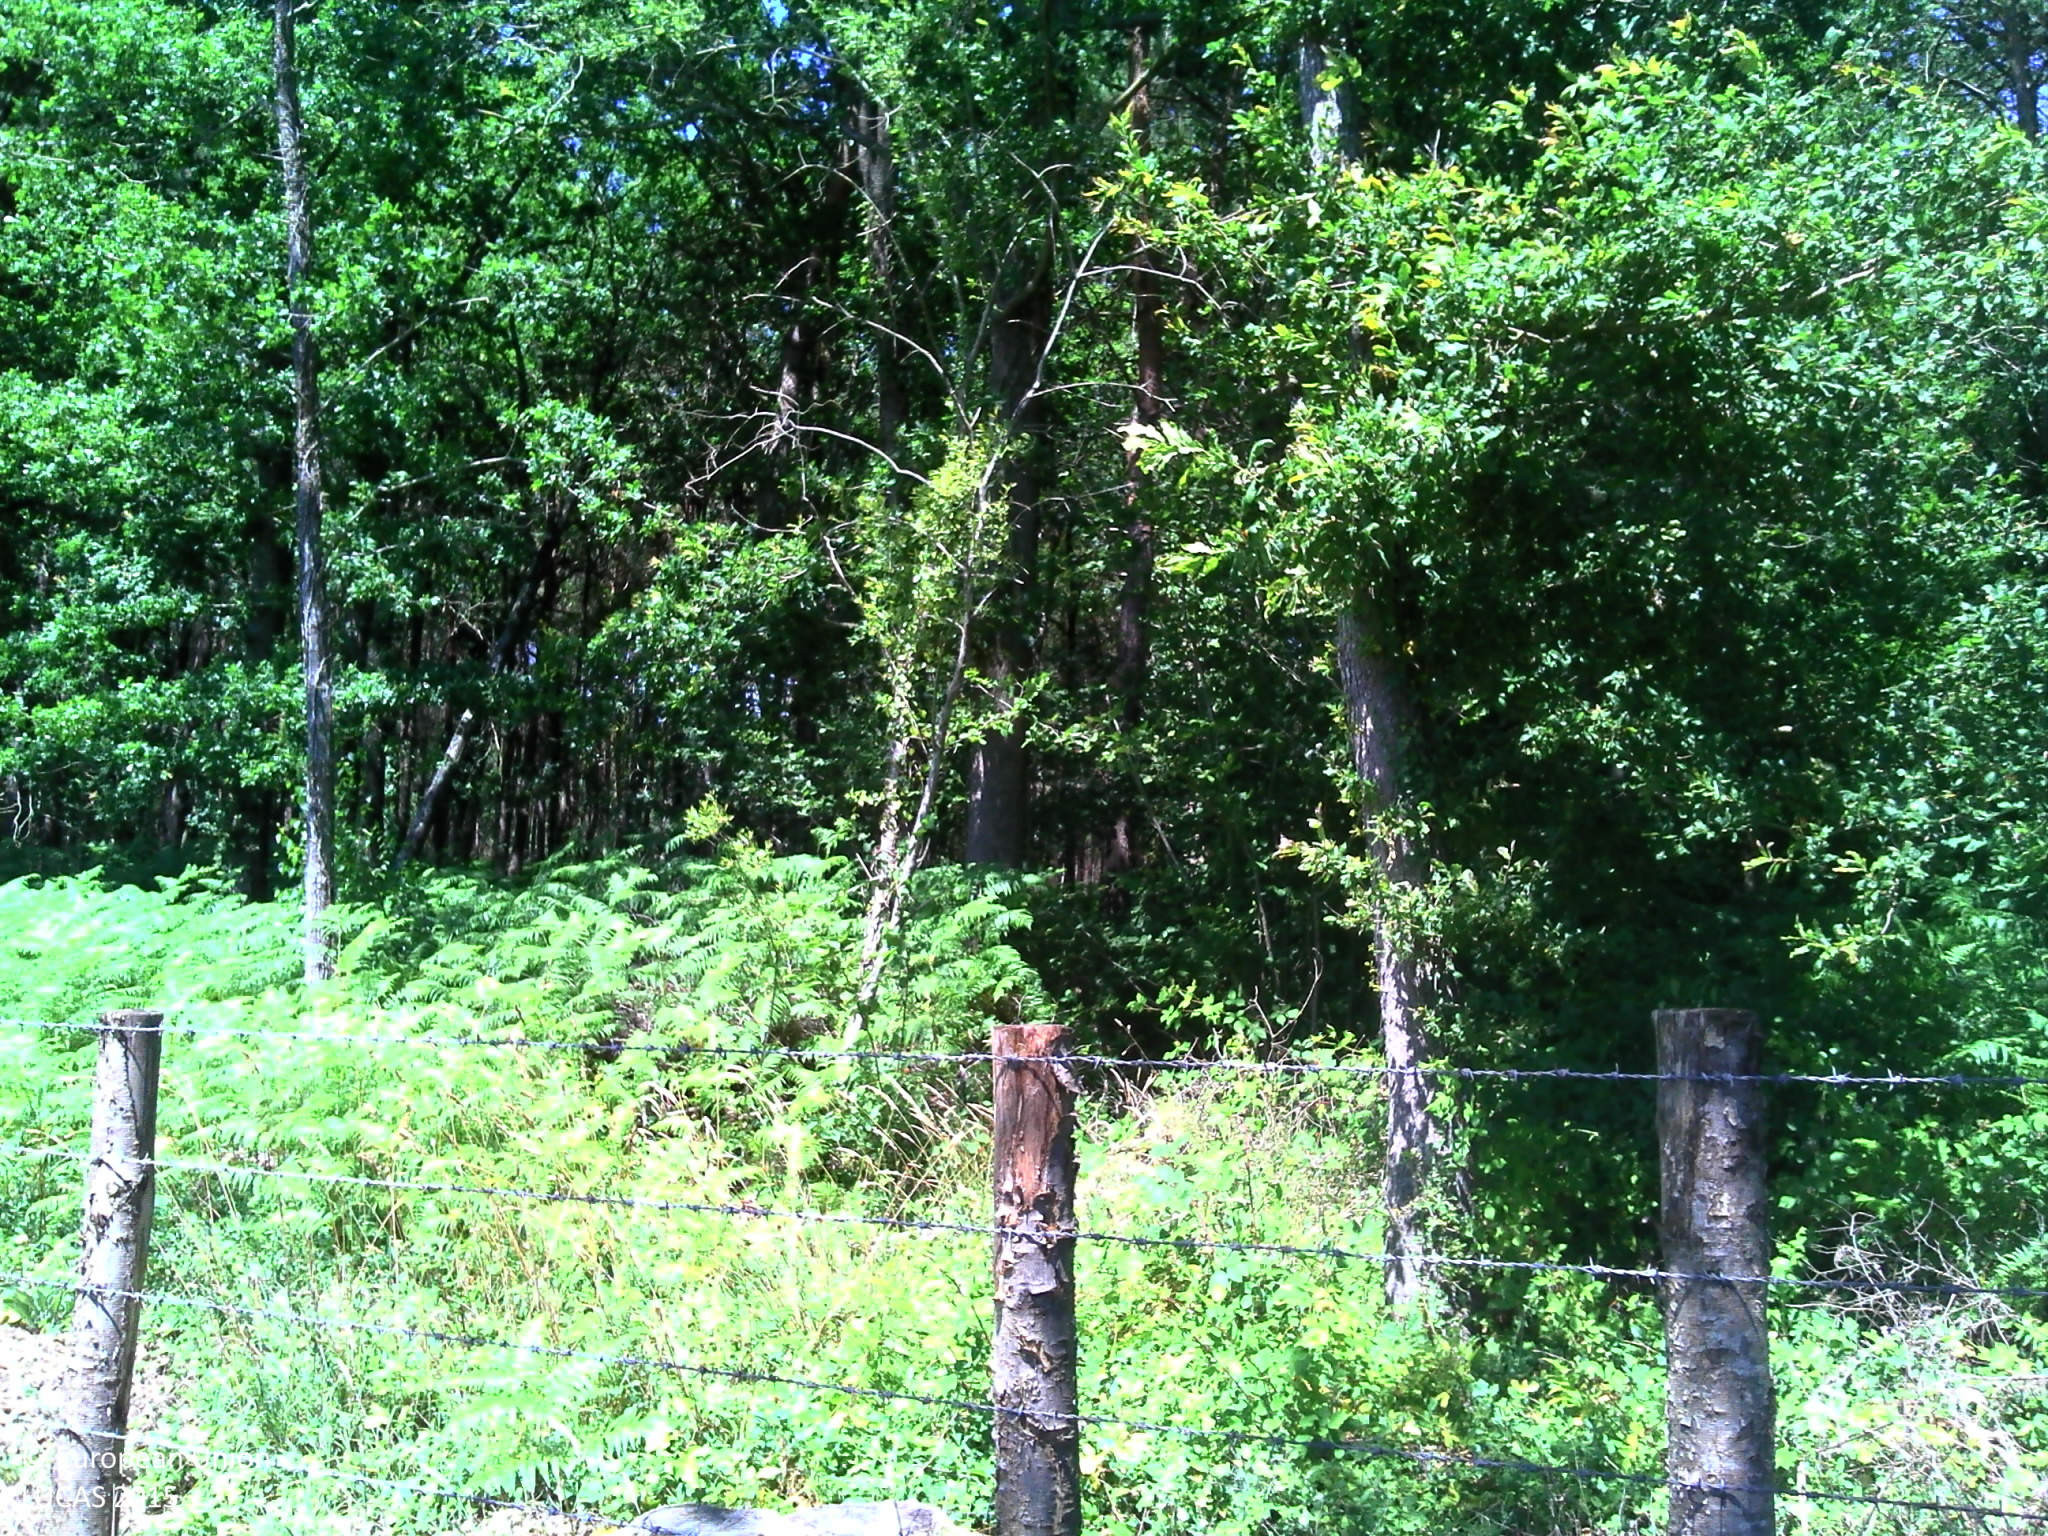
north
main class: Grassland
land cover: Grassland without tree/shrub cover
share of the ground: > 75 %
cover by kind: herbaceous plants 100 %
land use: Agriculture (excluding fallow land and kitchen gardens)
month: June
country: FR
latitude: 47.9573
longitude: 0.2929
